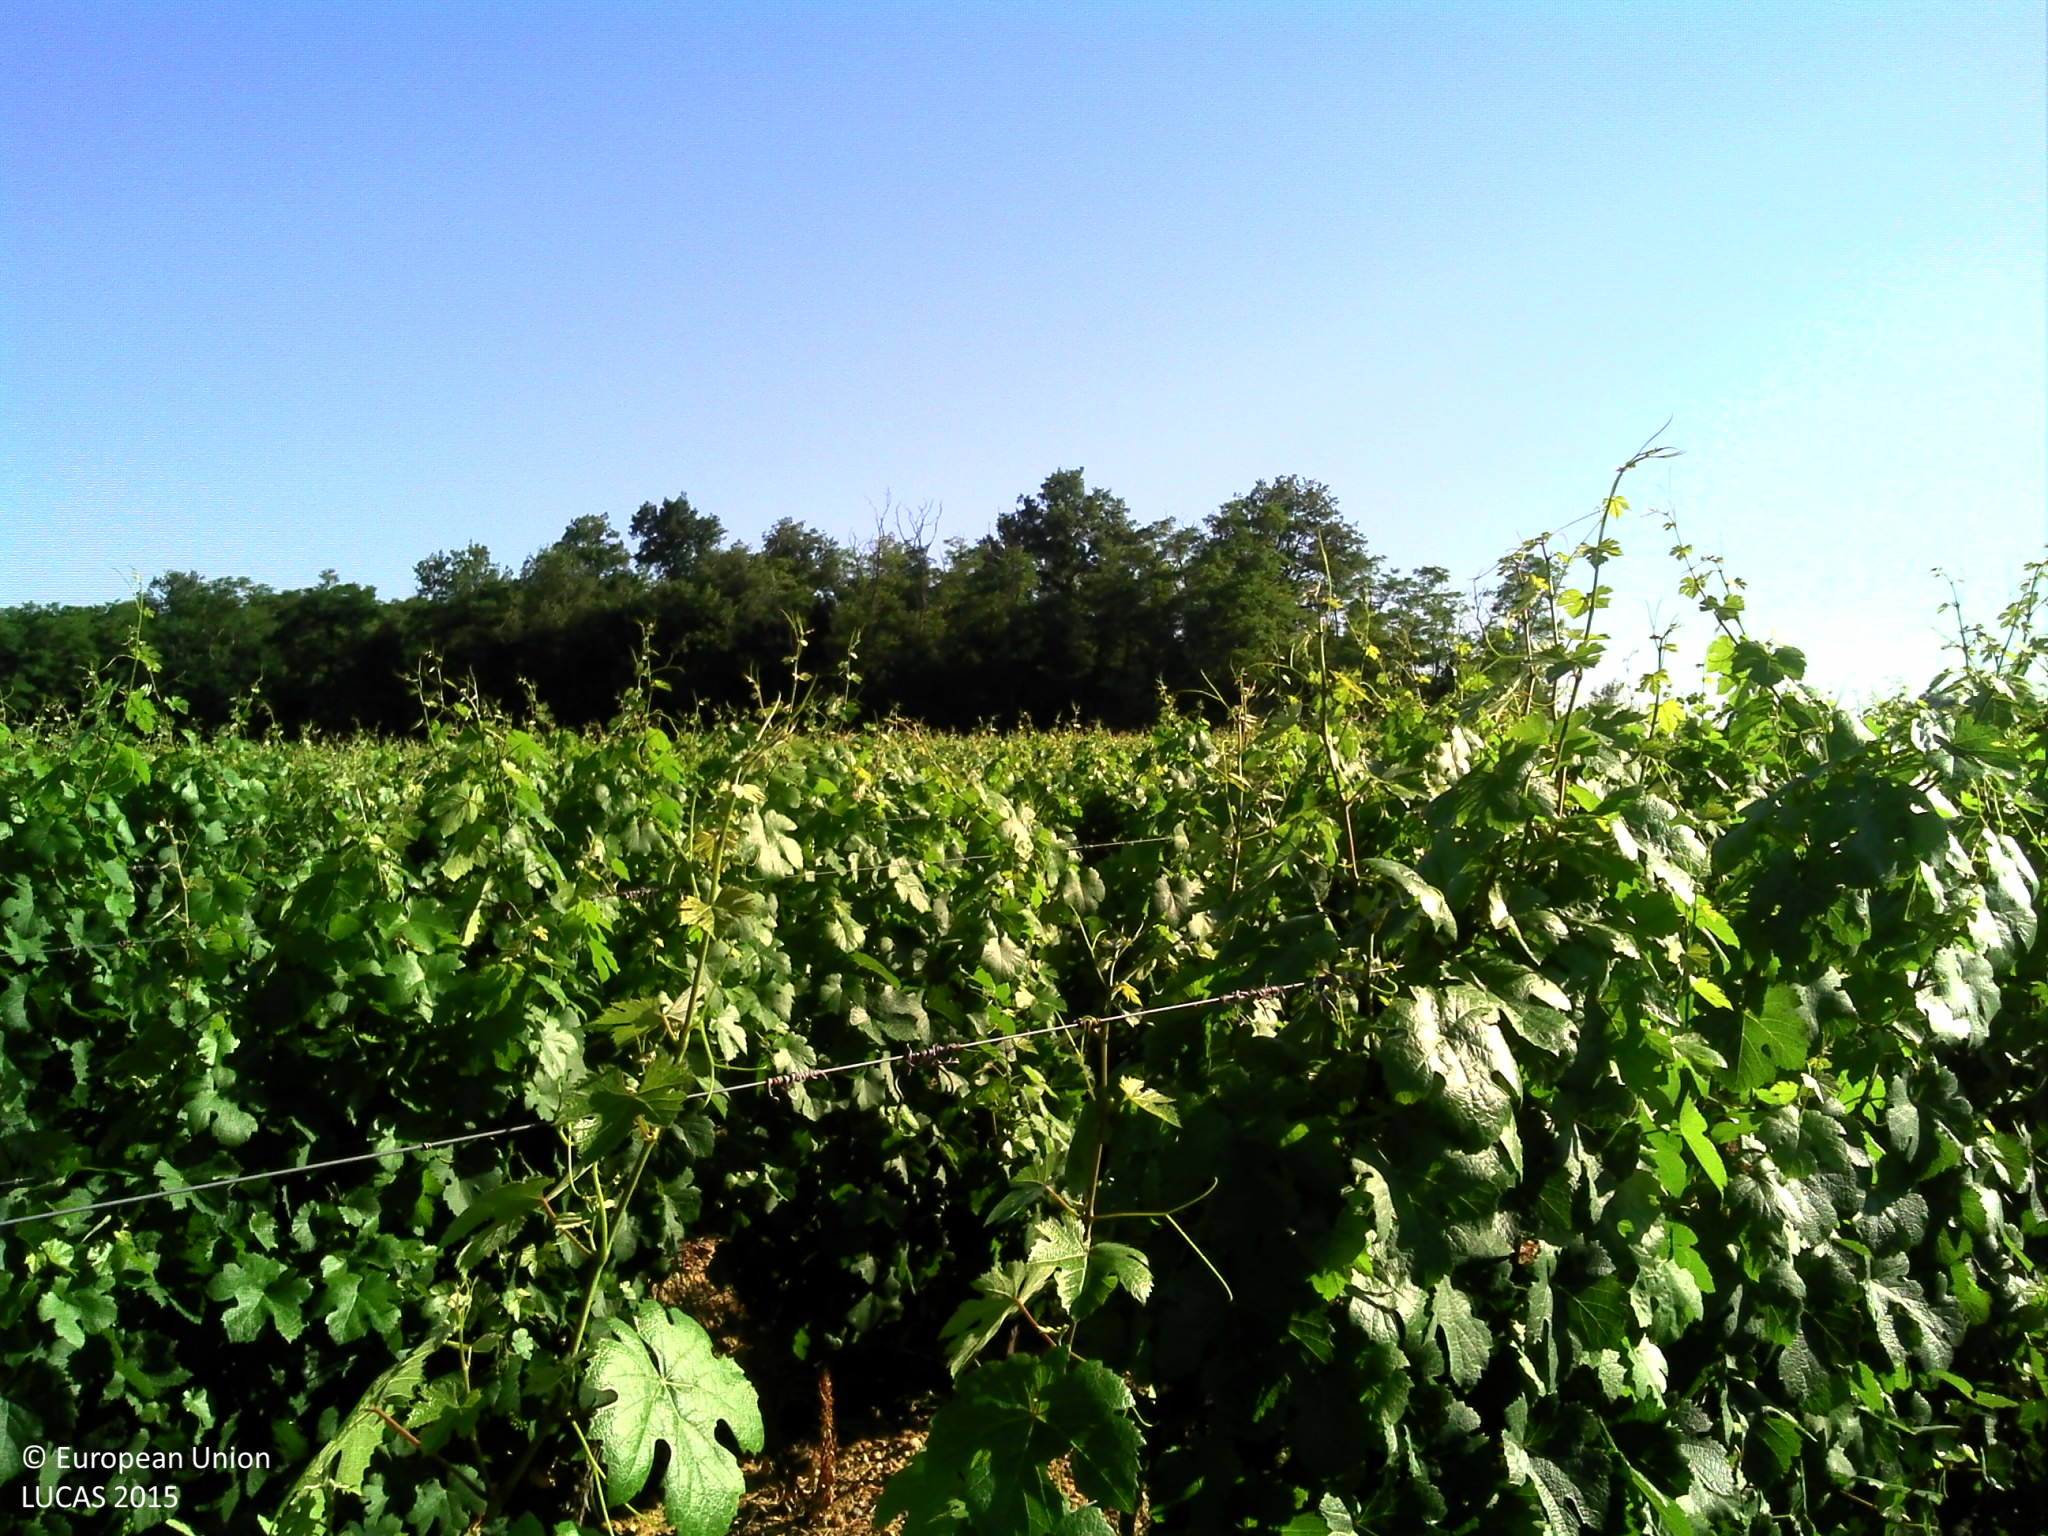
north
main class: Cropland
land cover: Vineyards
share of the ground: 25 - 50 %
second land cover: Grassland without tree/shrub cover
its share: 50 - 75 %
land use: Agriculture (excluding fallow land and kitchen gardens)
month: June
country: FR
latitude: 43.8443
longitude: 1.3562
